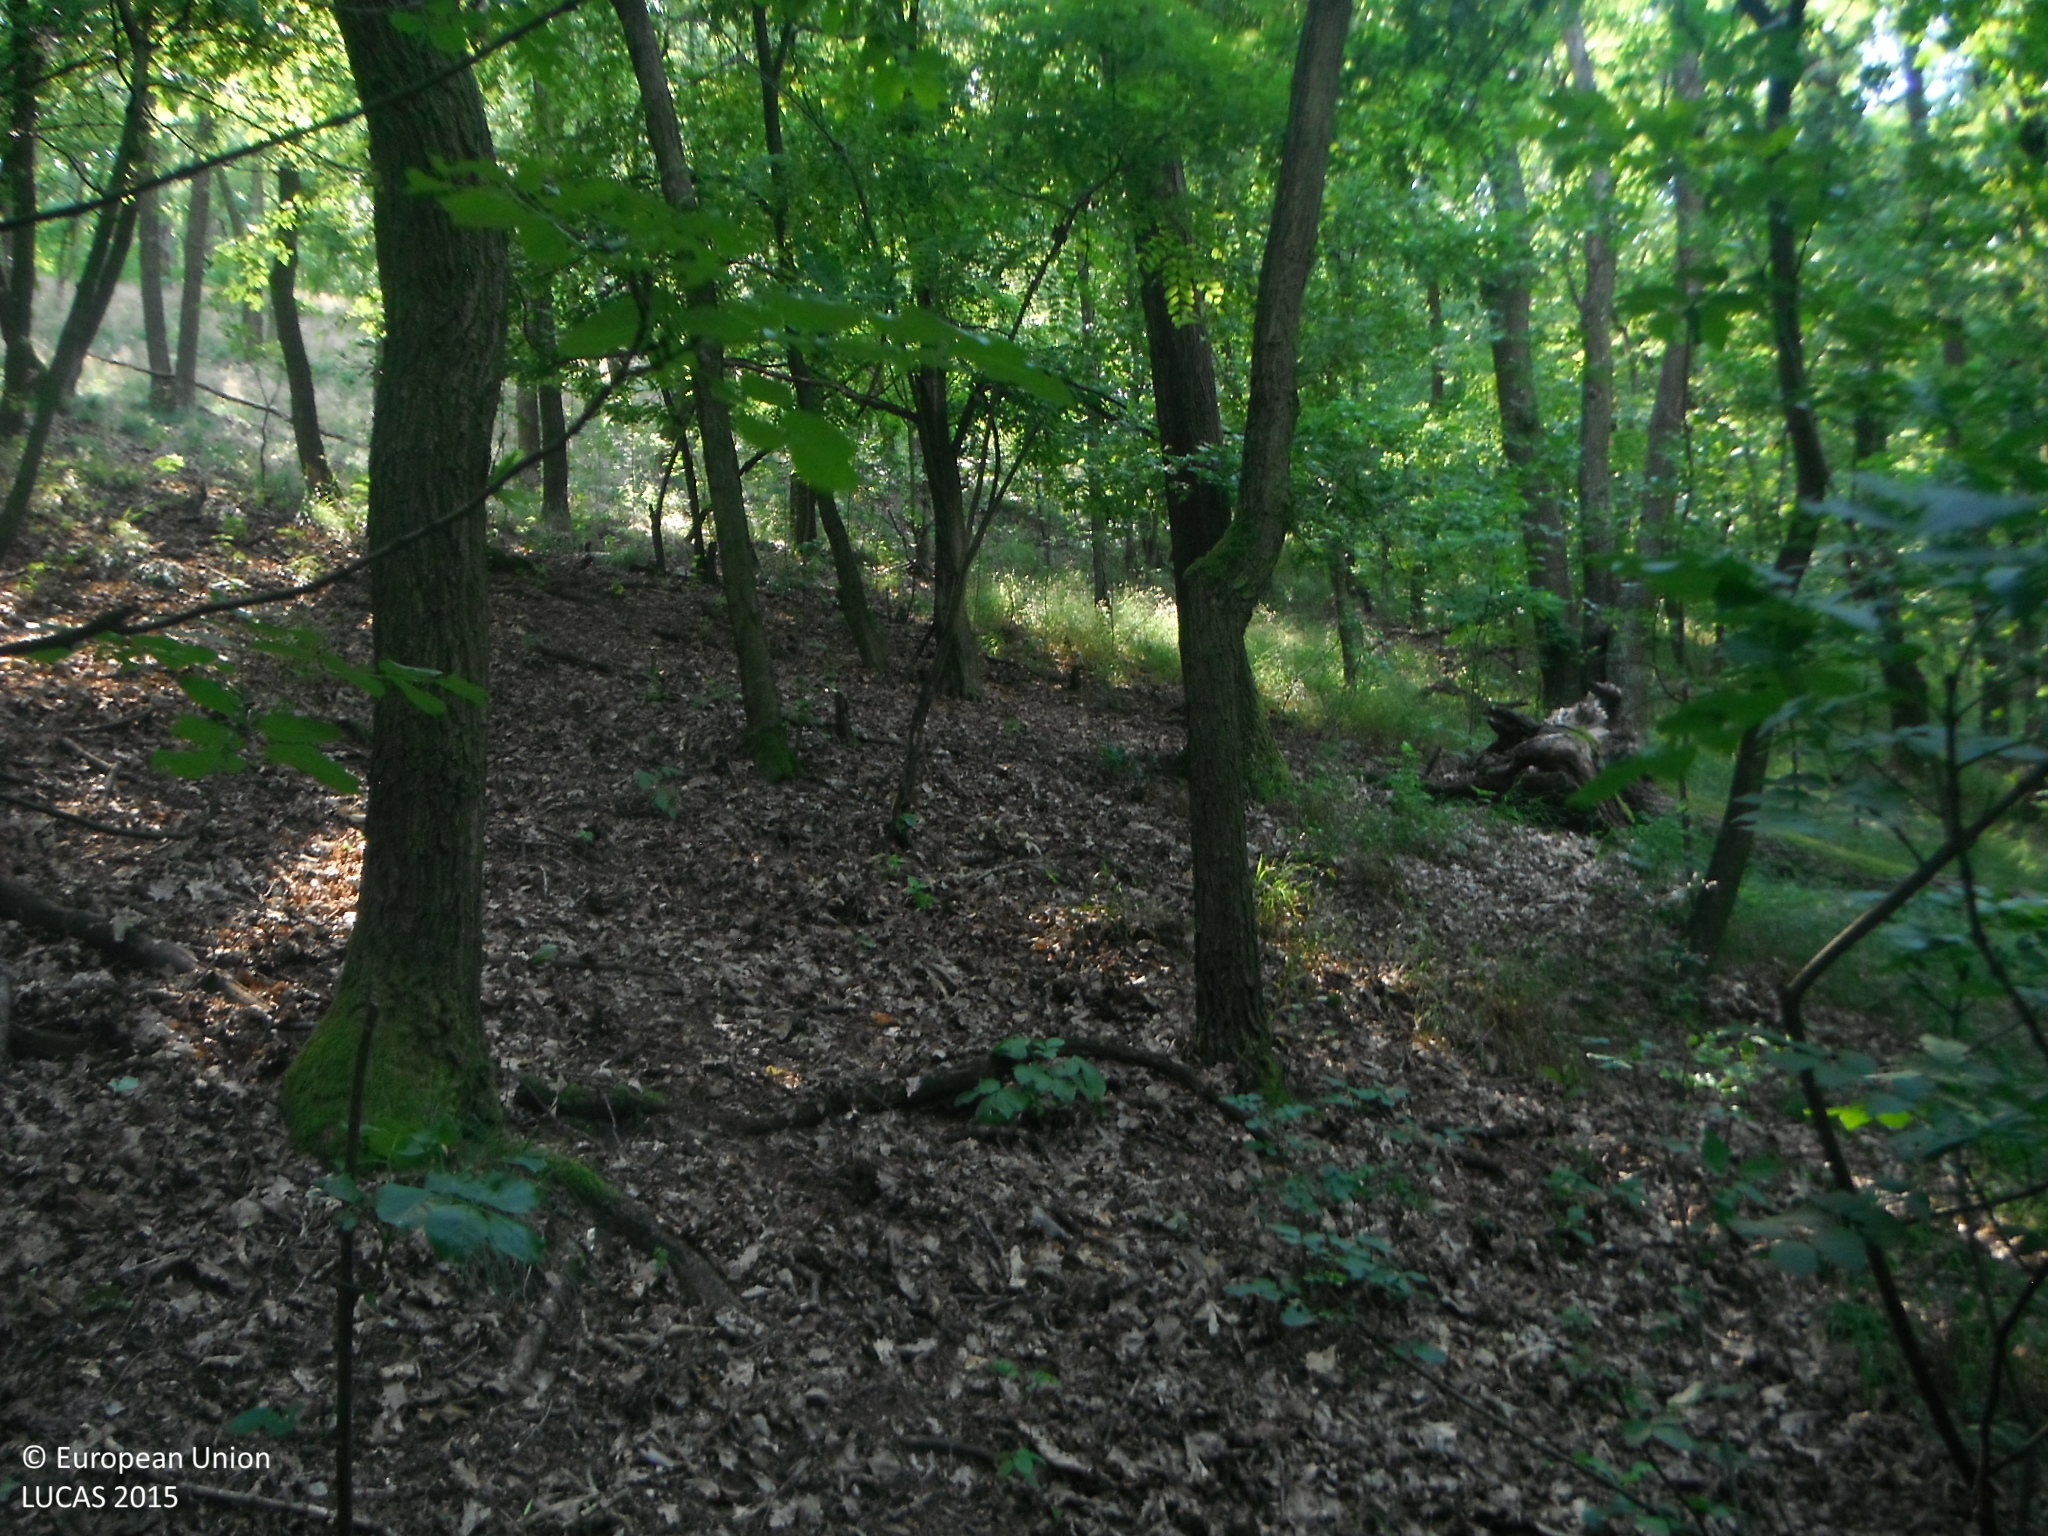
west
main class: Woodland
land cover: Broadleaved woodland
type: acidophilous oak and oak-birch forest
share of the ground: > 75 %
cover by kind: broadleaved forest trees 90 %, herbaceous plants 10 %
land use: Forestry
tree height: > 5 m
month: July
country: SK
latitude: 48.3871
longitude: 18.2114
